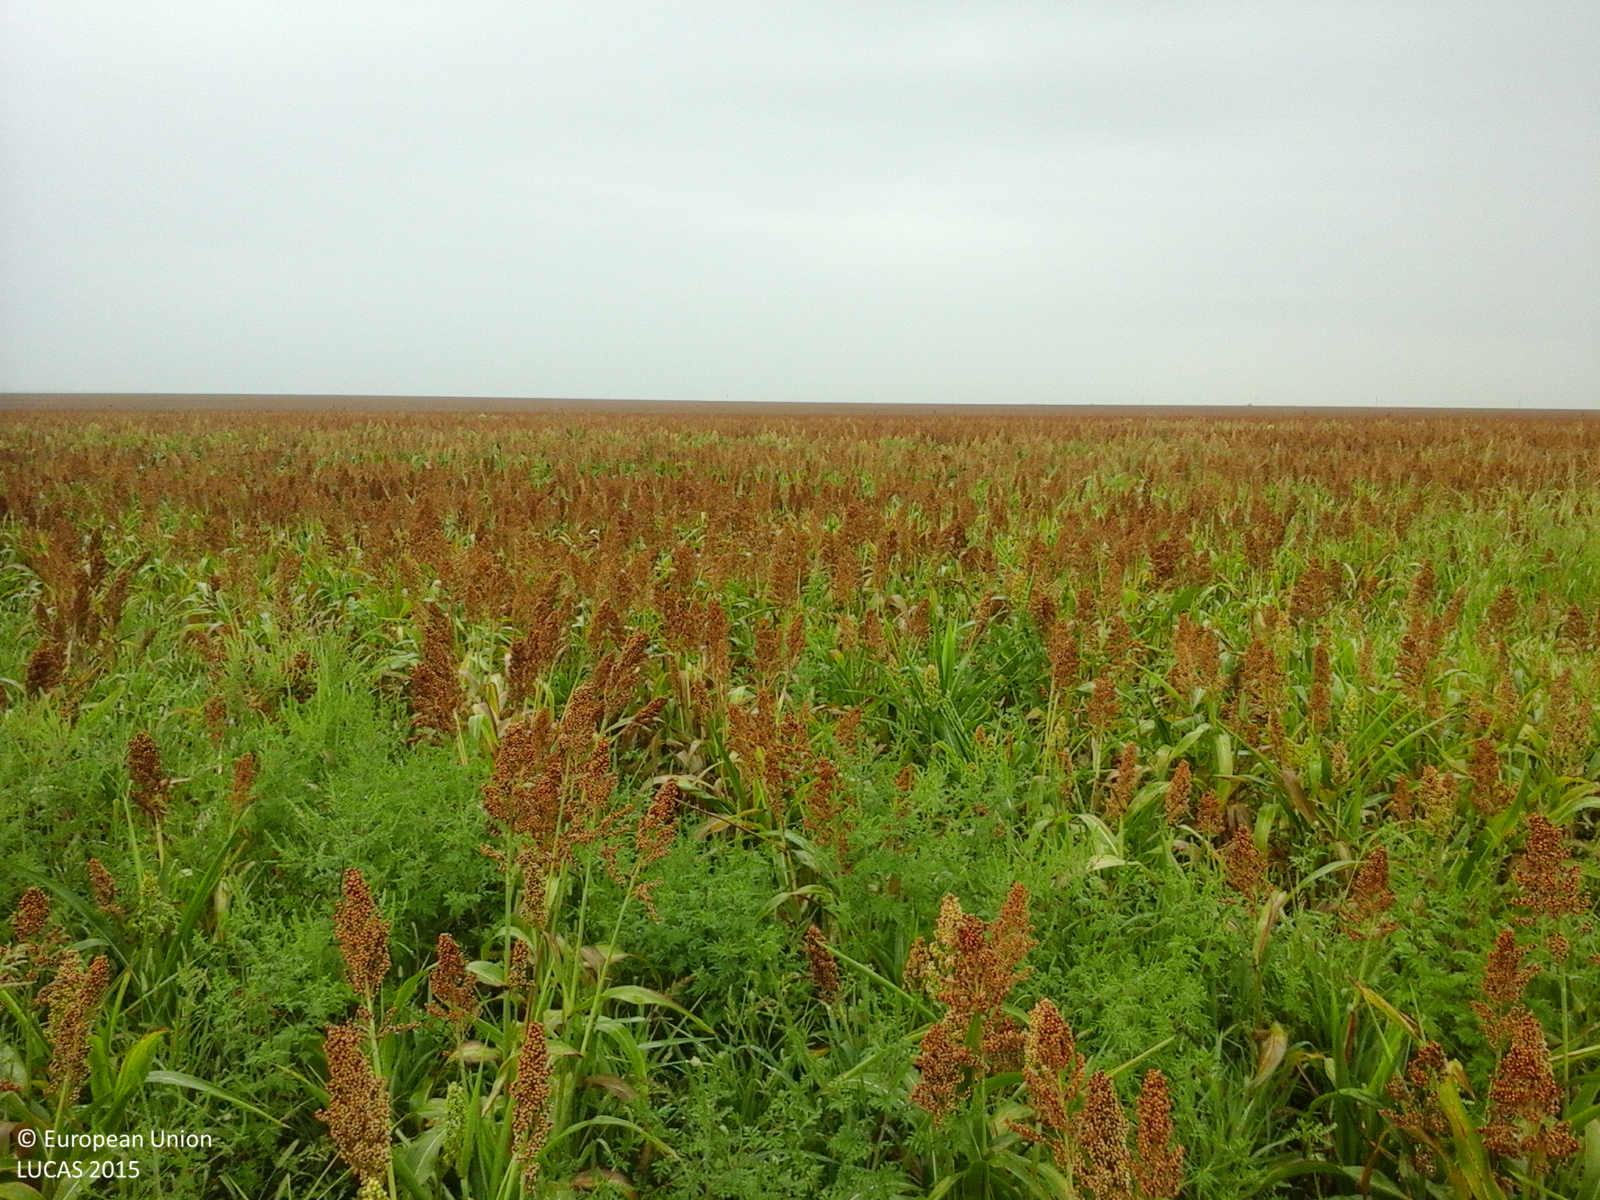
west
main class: Cropland
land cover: Other cereals
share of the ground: > 75 %
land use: Agriculture (excluding fallow land and kitchen gardens)
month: August
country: RO
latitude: 45.4762
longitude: 21.4810
